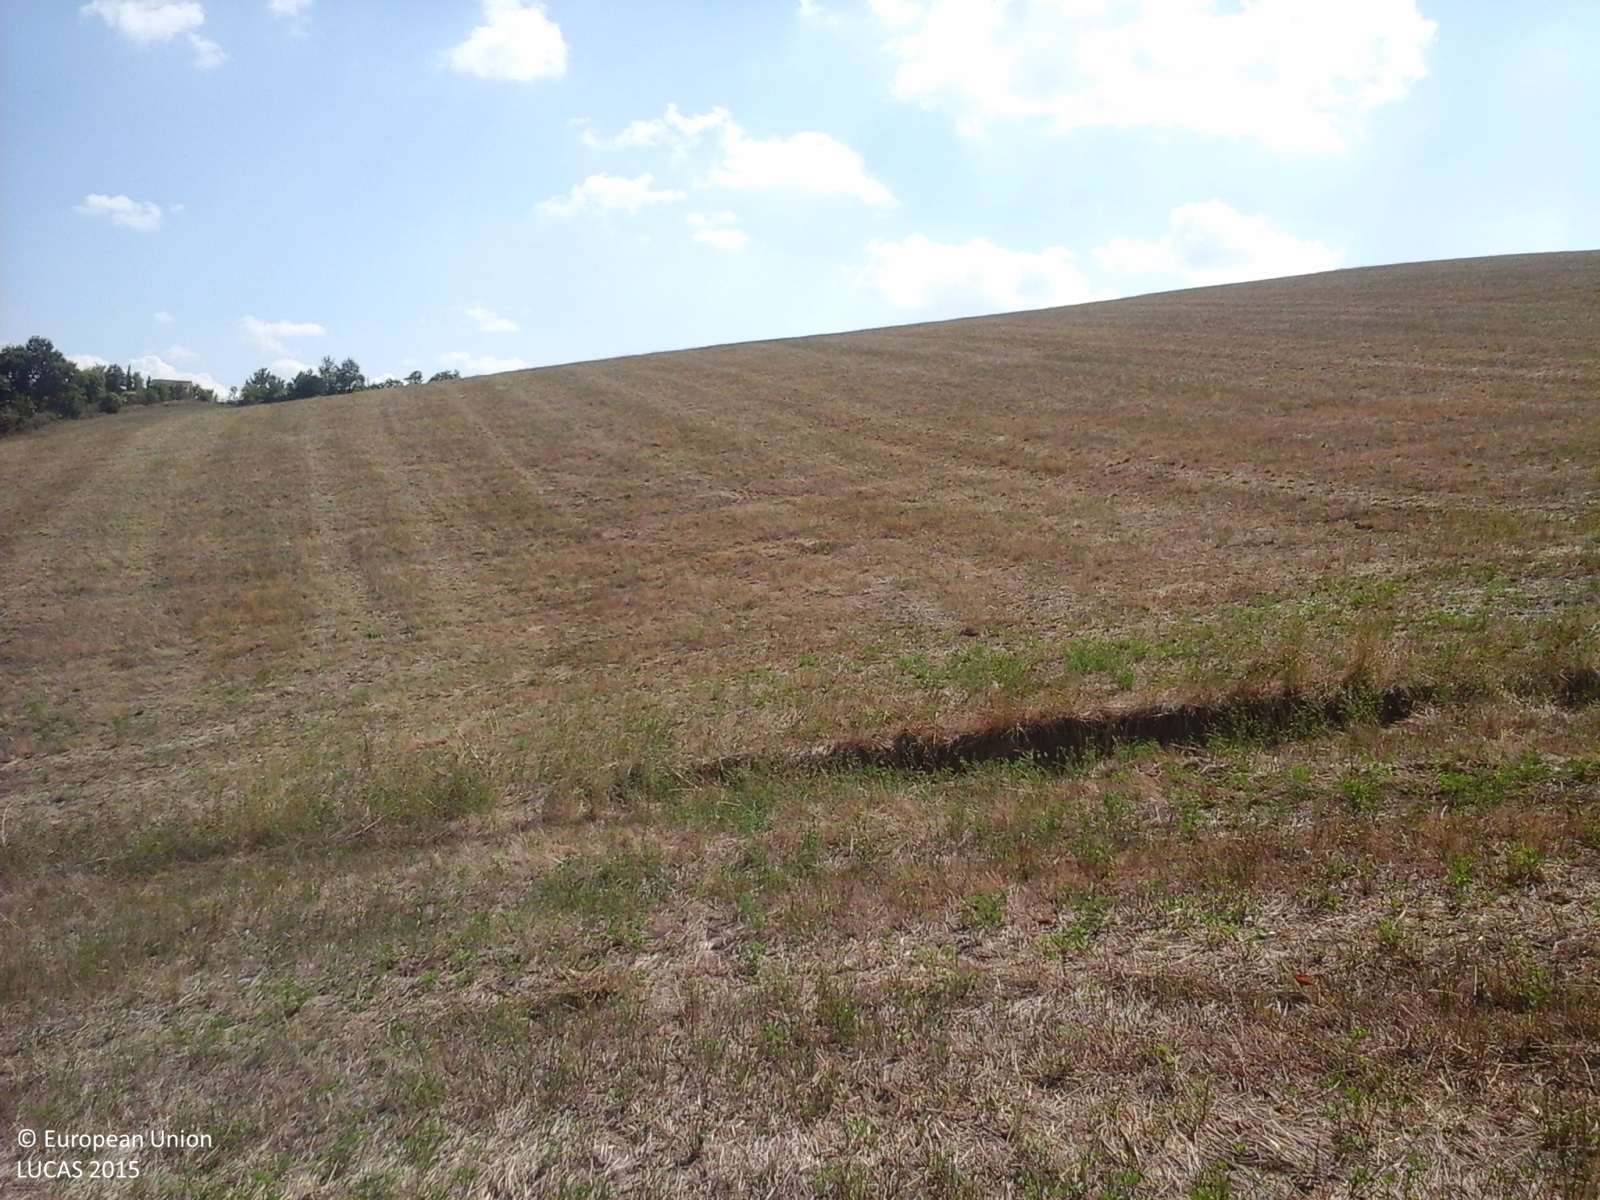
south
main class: Cropland
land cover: Lucerne
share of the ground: > 75 %
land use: Agriculture (excluding fallow land and kitchen gardens)
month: August
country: IT
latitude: 43.7749
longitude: 12.6647
